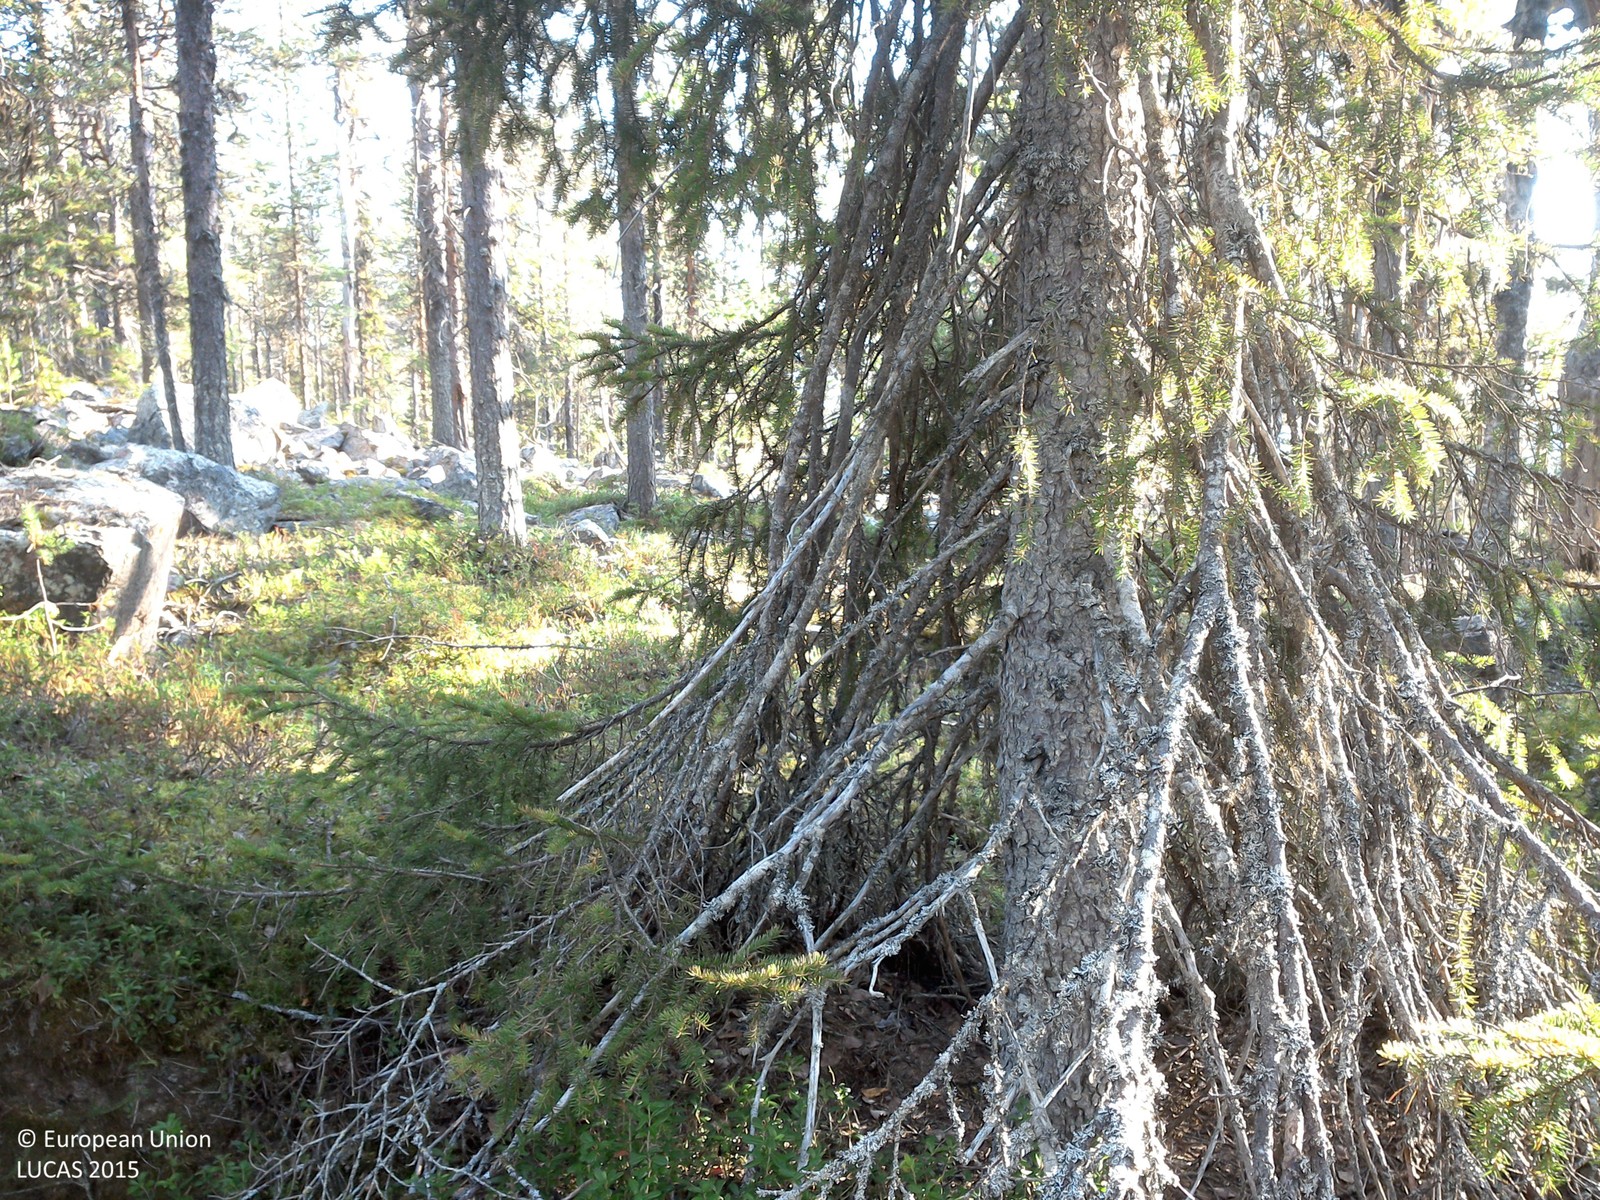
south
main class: Woodland
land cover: Pine dominated mixed woodland
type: boreal forest
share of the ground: 25 - 50 %
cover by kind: lichens and mosses 40 %, coniferous forest trees 25 %, shrubs 15 %, broadleaved forest trees 10 %, unconsolidated bare surface 10 %
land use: Forestry
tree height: > 5 m
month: August
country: SE
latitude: 67.1523
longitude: 22.4946
